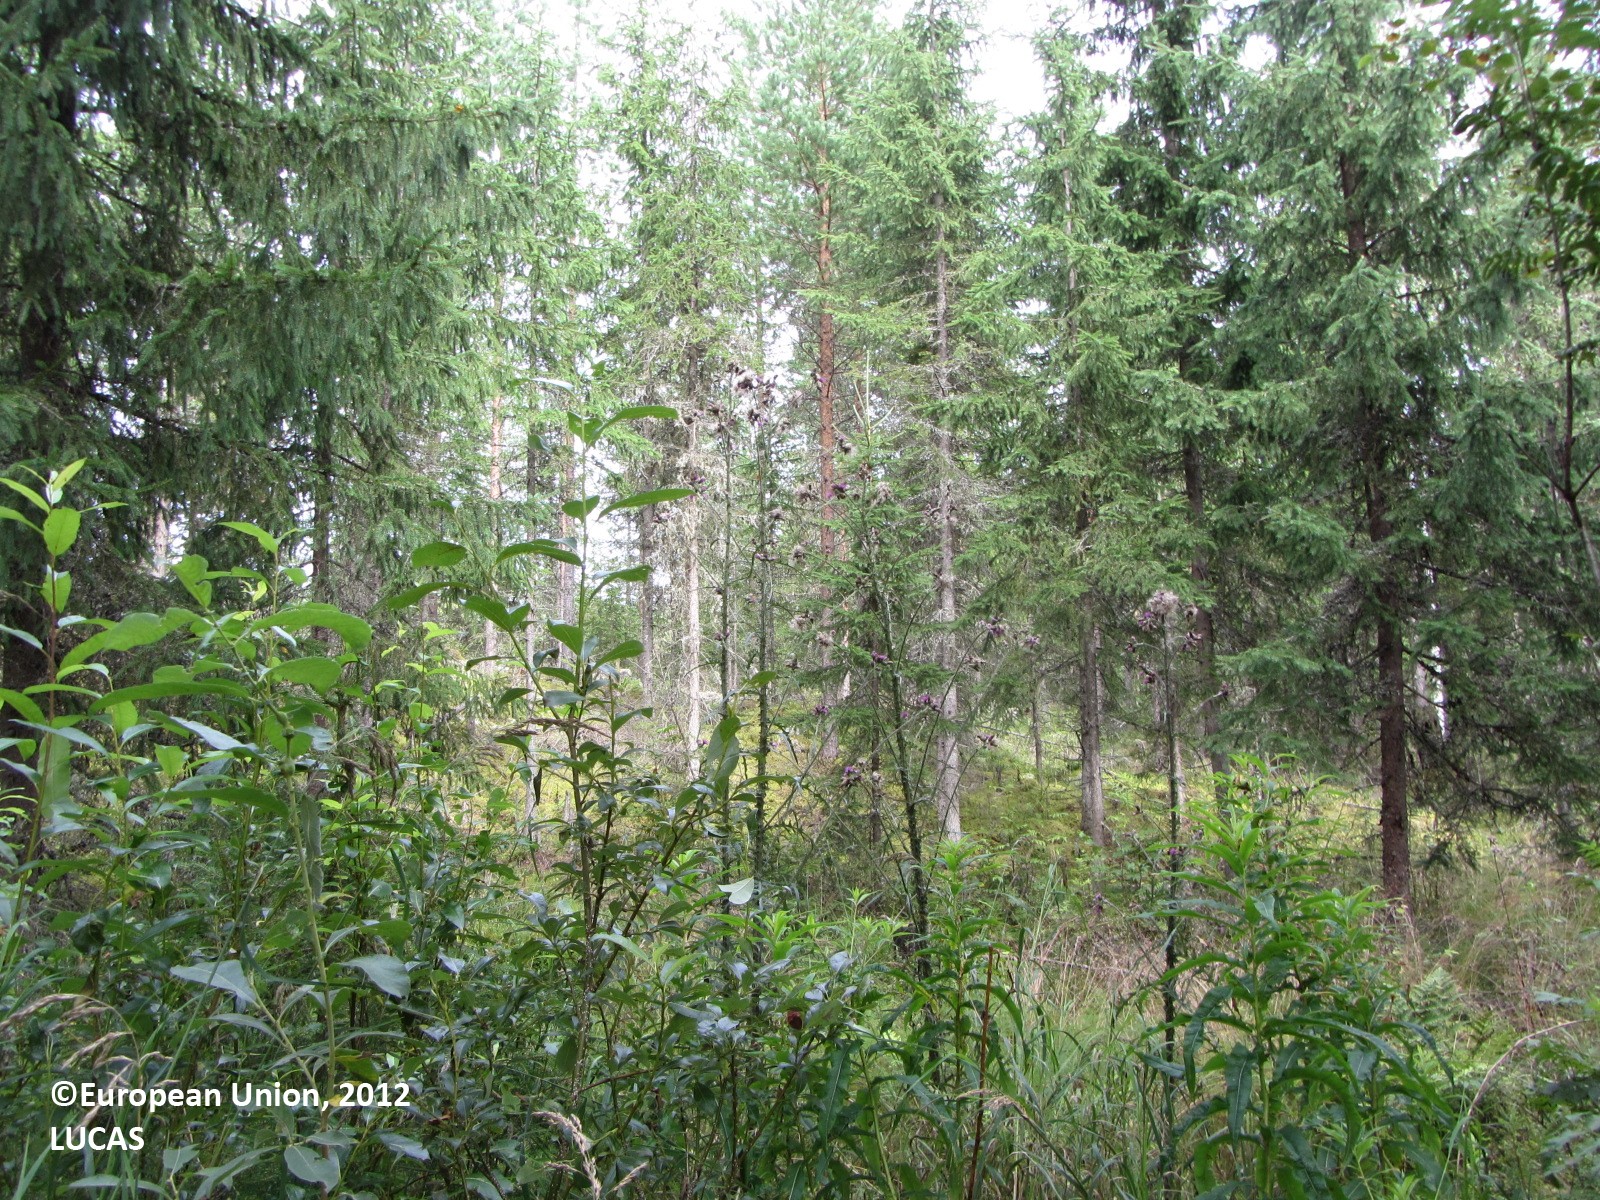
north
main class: Woodland
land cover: Spruce dominated mixed woodland
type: boreal forest
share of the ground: > 75 %
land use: Forestry
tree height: > 5 m
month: August
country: FI
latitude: 63.2523
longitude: 25.2135
